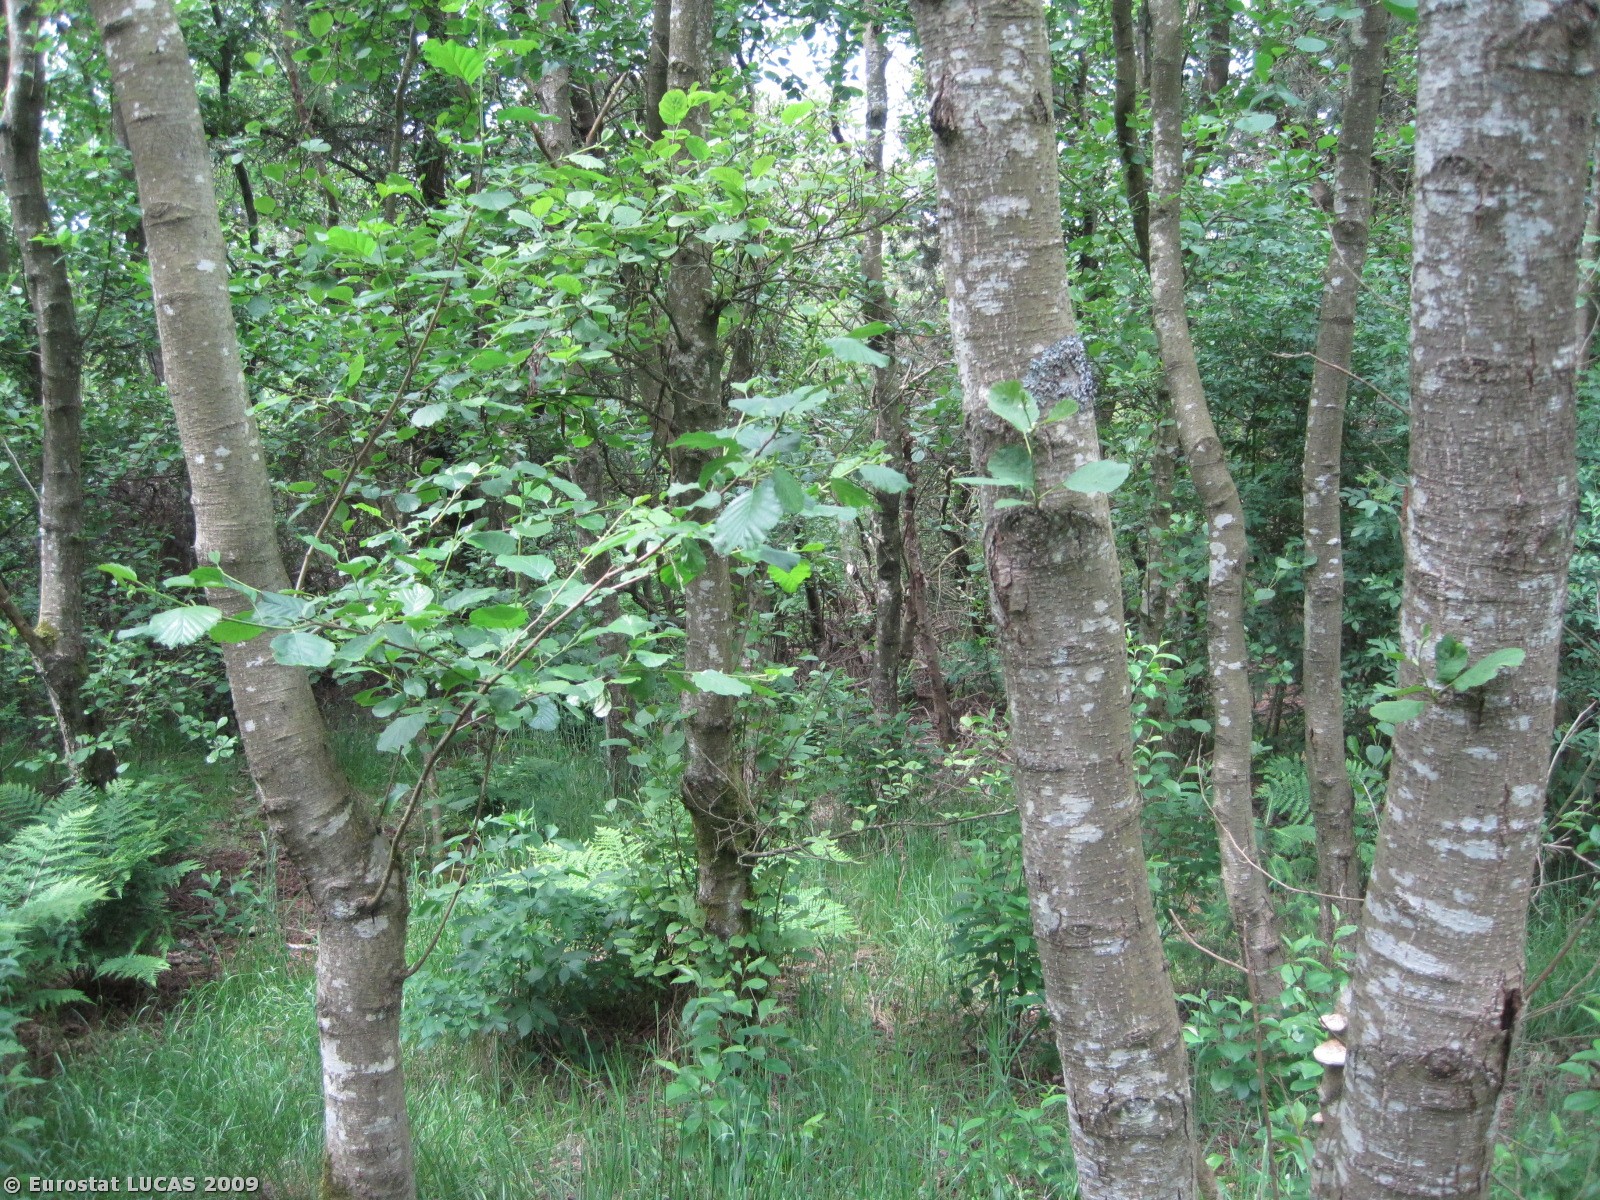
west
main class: Woodland
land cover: Mixed woodland
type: plantations and self-sown exotic forest
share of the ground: 50 - 75 %
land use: Forestry
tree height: > 5 m
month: June
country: DK
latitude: 57.3560
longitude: 9.7179
